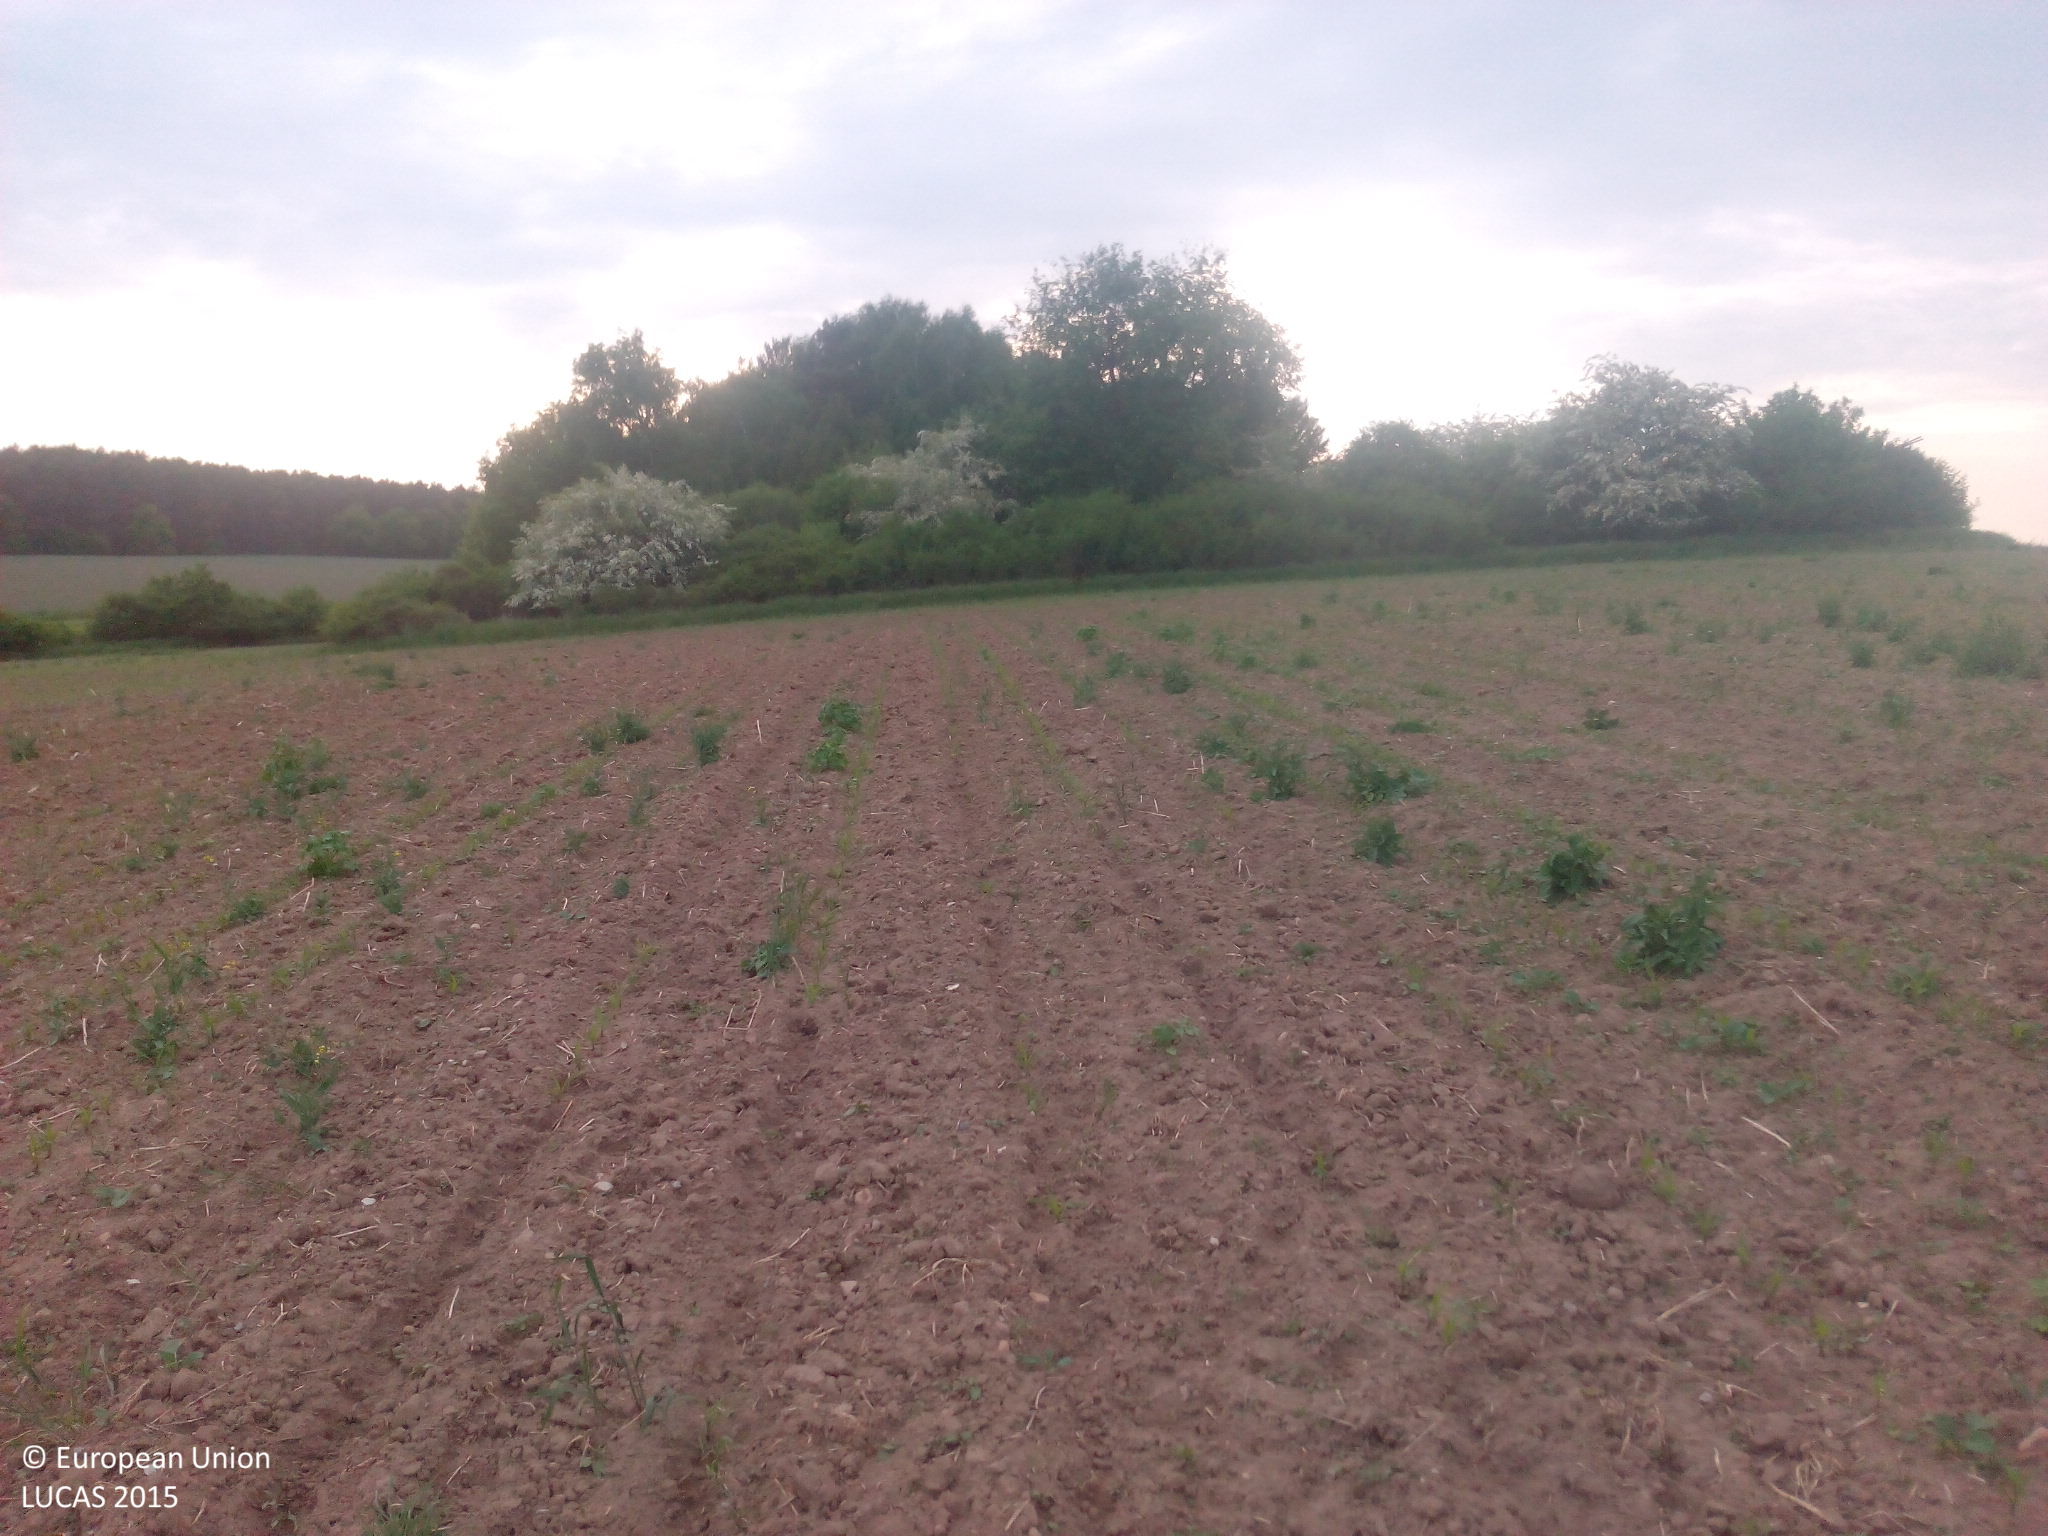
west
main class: Cropland
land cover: Maize
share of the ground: < 10 %
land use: Agriculture (excluding fallow land and kitchen gardens)
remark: Tilled/Sowed
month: May
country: DE
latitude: 52.2302
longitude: 13.0599
